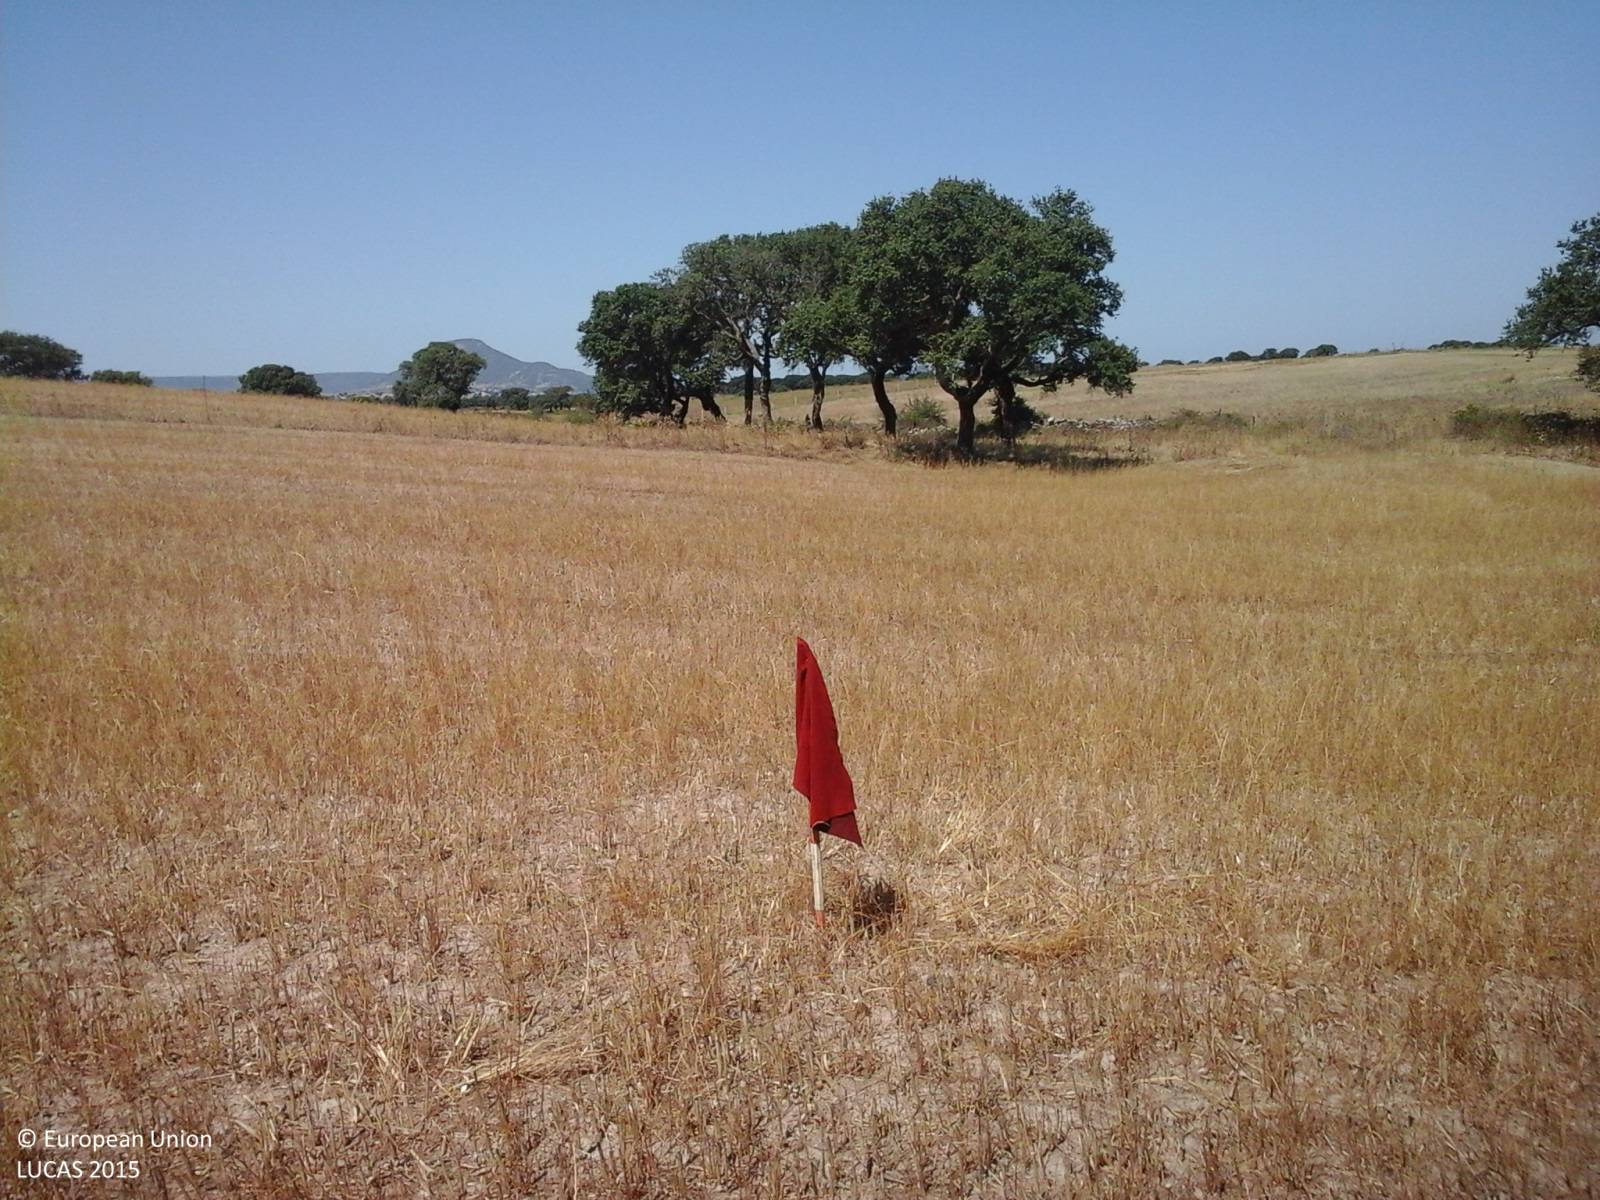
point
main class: Cropland
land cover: Oats
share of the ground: < 10 %
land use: Agriculture (excluding fallow land and kitchen gardens)
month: July
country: IT
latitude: 40.5871
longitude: 8.9066
